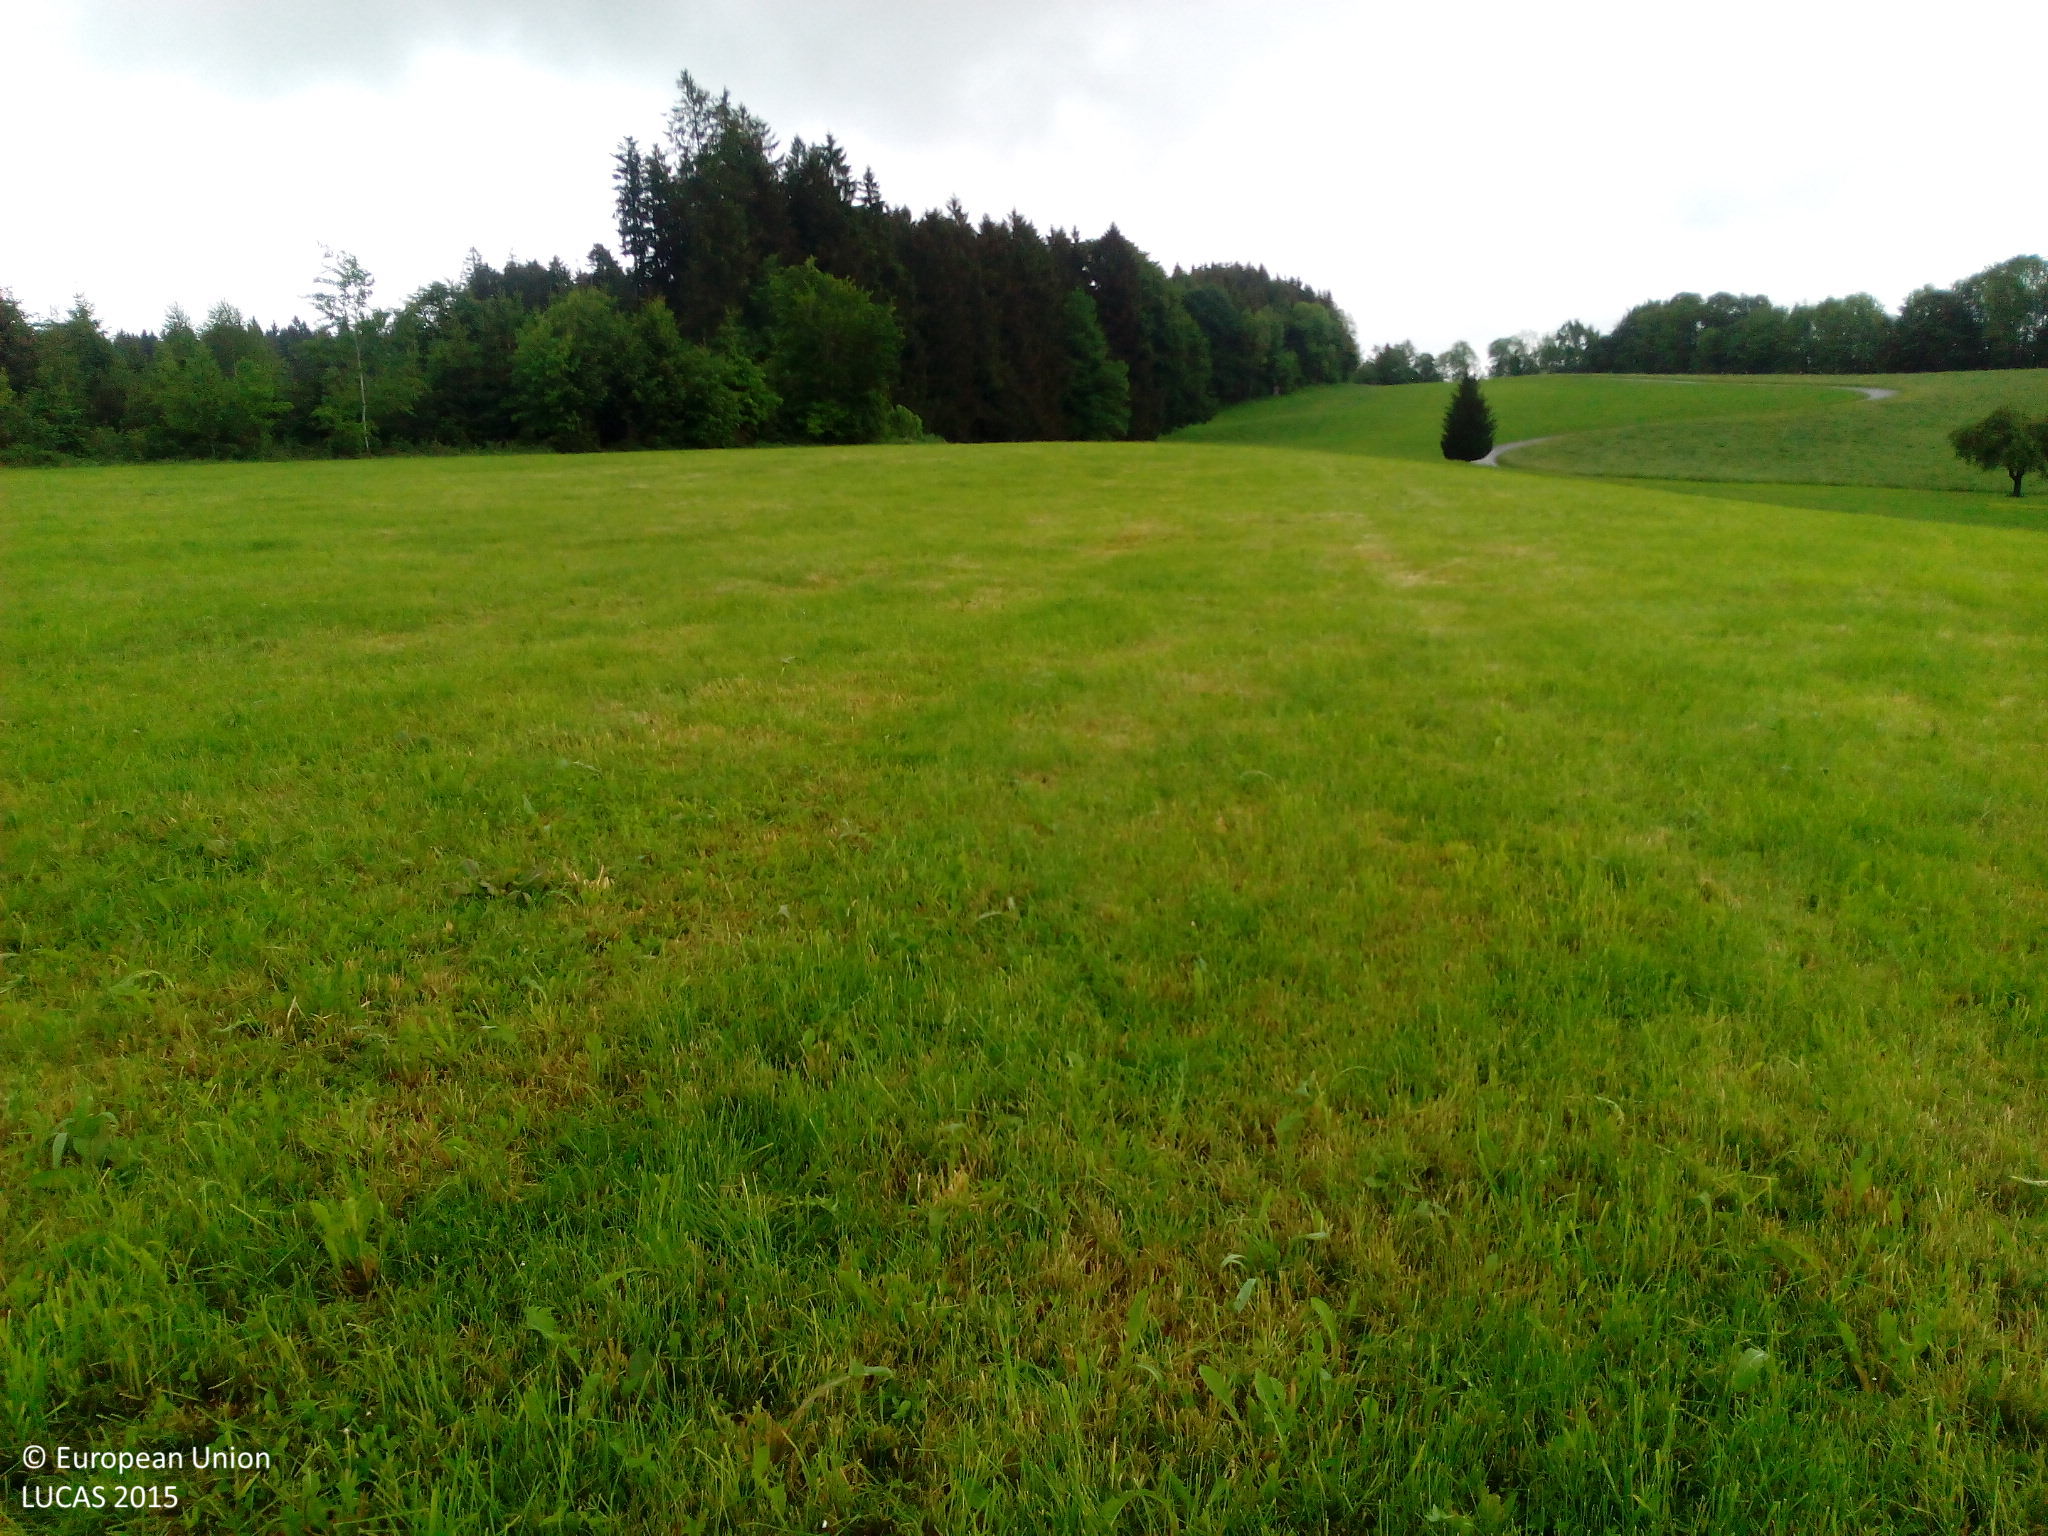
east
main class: Grassland
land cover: Grassland without tree/shrub cover
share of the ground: > 75 %
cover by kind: herbaceous plants 100 %
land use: Agriculture (excluding fallow land and kitchen gardens)
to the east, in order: Grassland without tree/shrub cover; Spruce dominated coniferous woodland
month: May
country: DE
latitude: 47.7556
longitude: 9.9334
